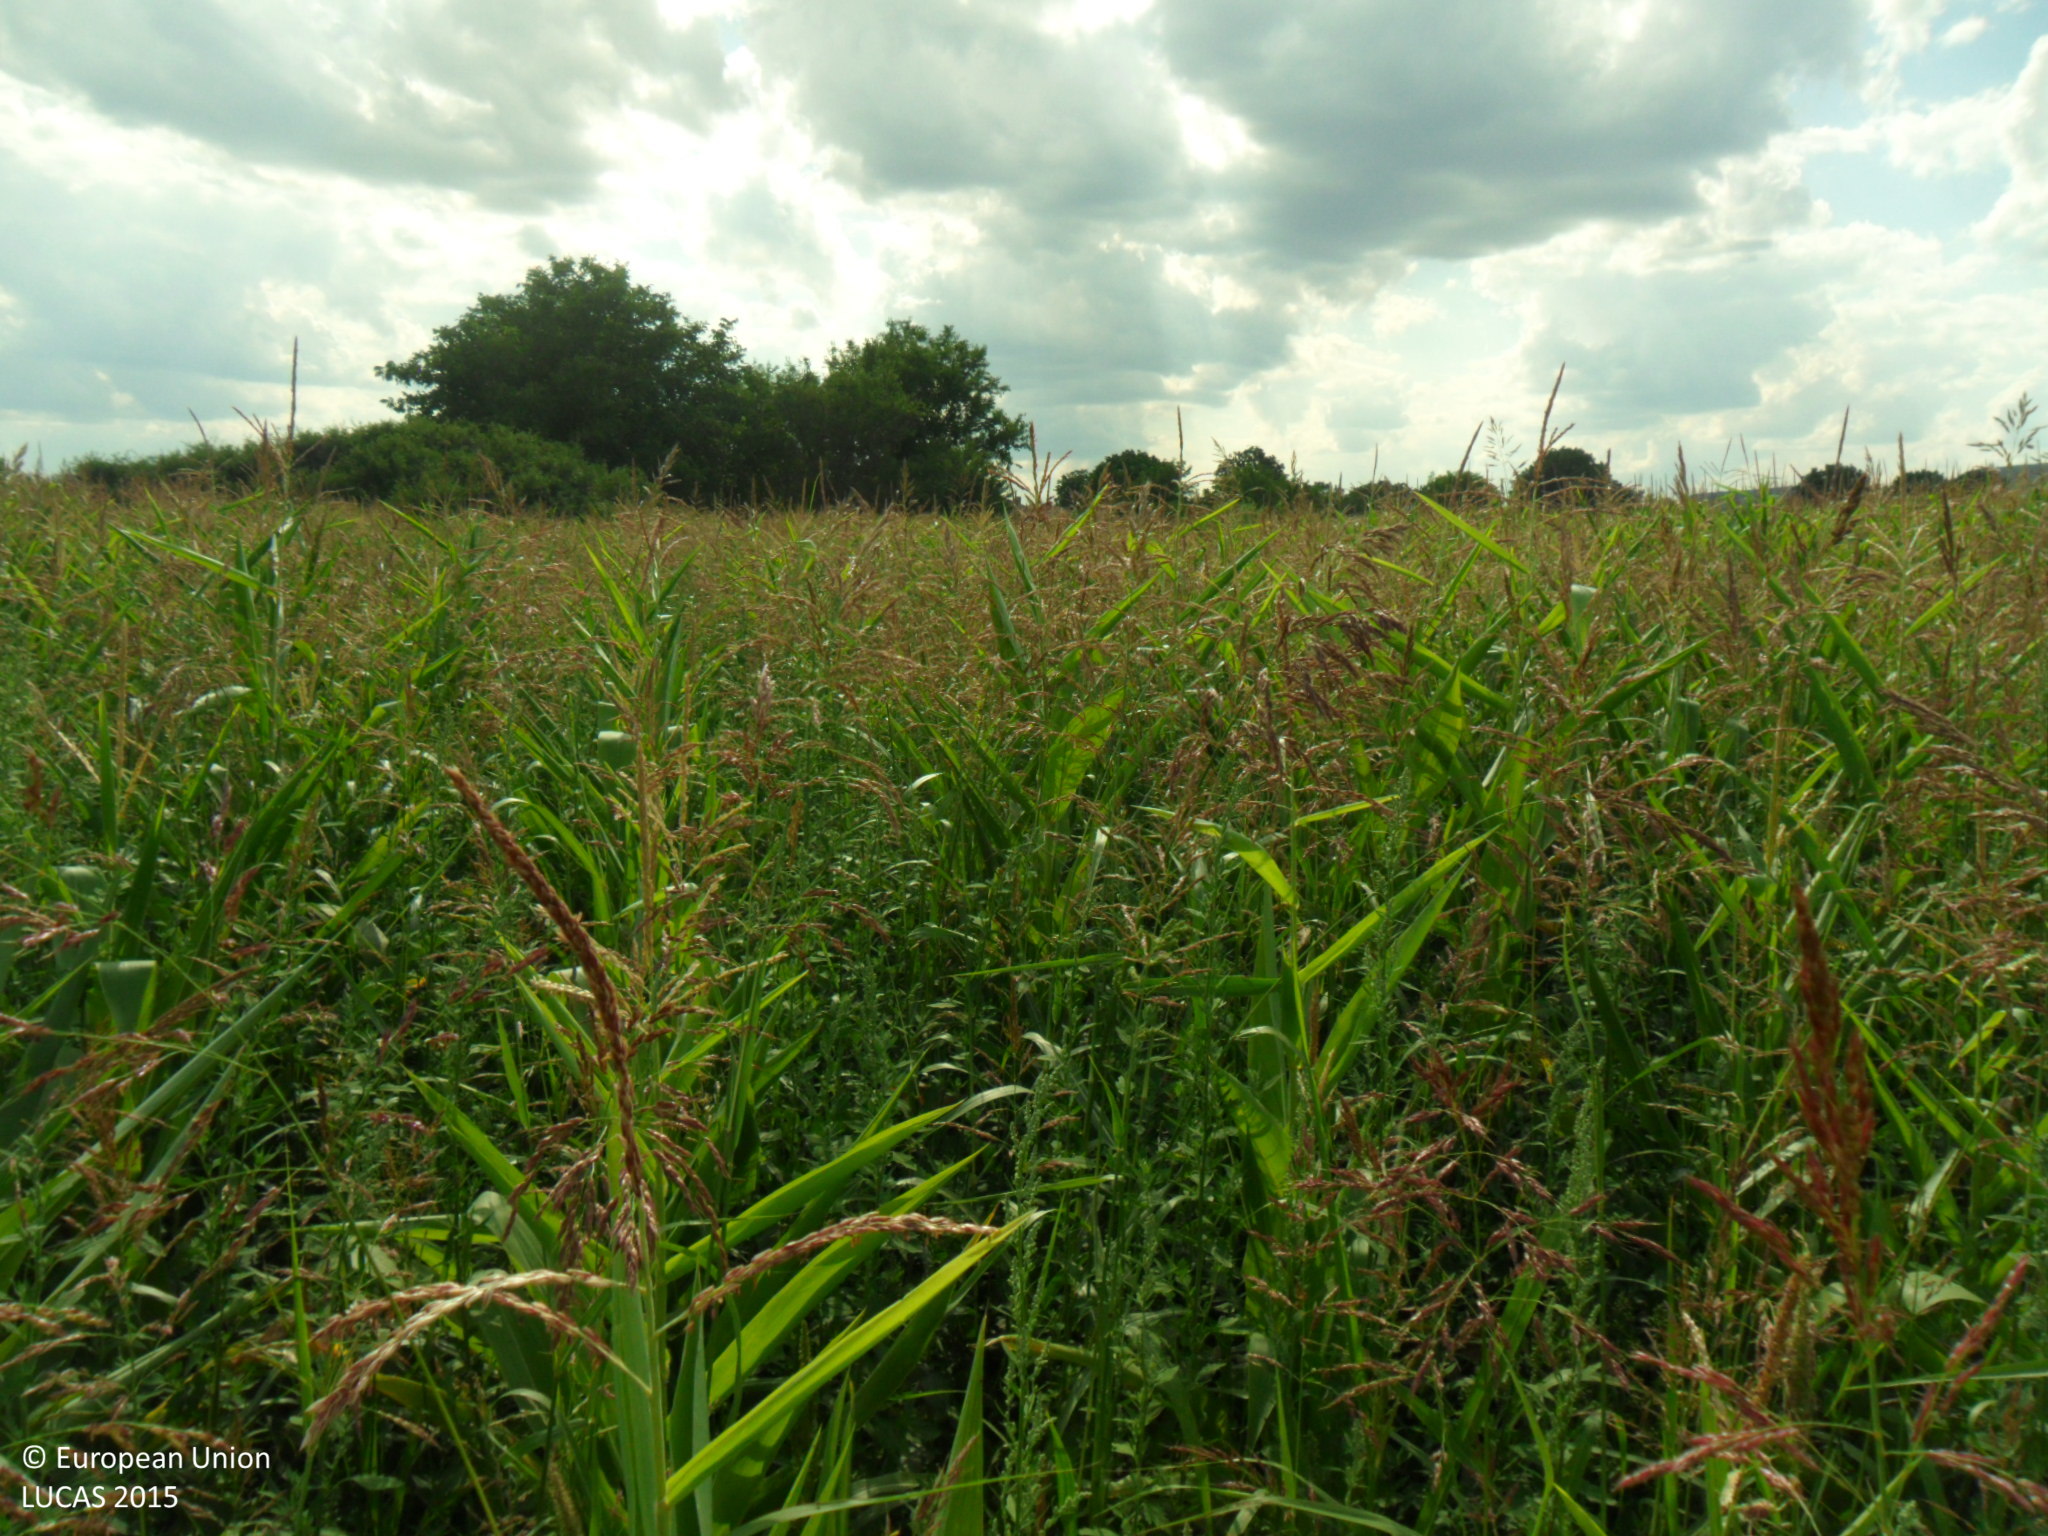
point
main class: Cropland
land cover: Maize
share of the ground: > 75 %
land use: Agriculture (excluding fallow land and kitchen gardens)
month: July
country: BG
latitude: 43.1995
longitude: 26.9604
